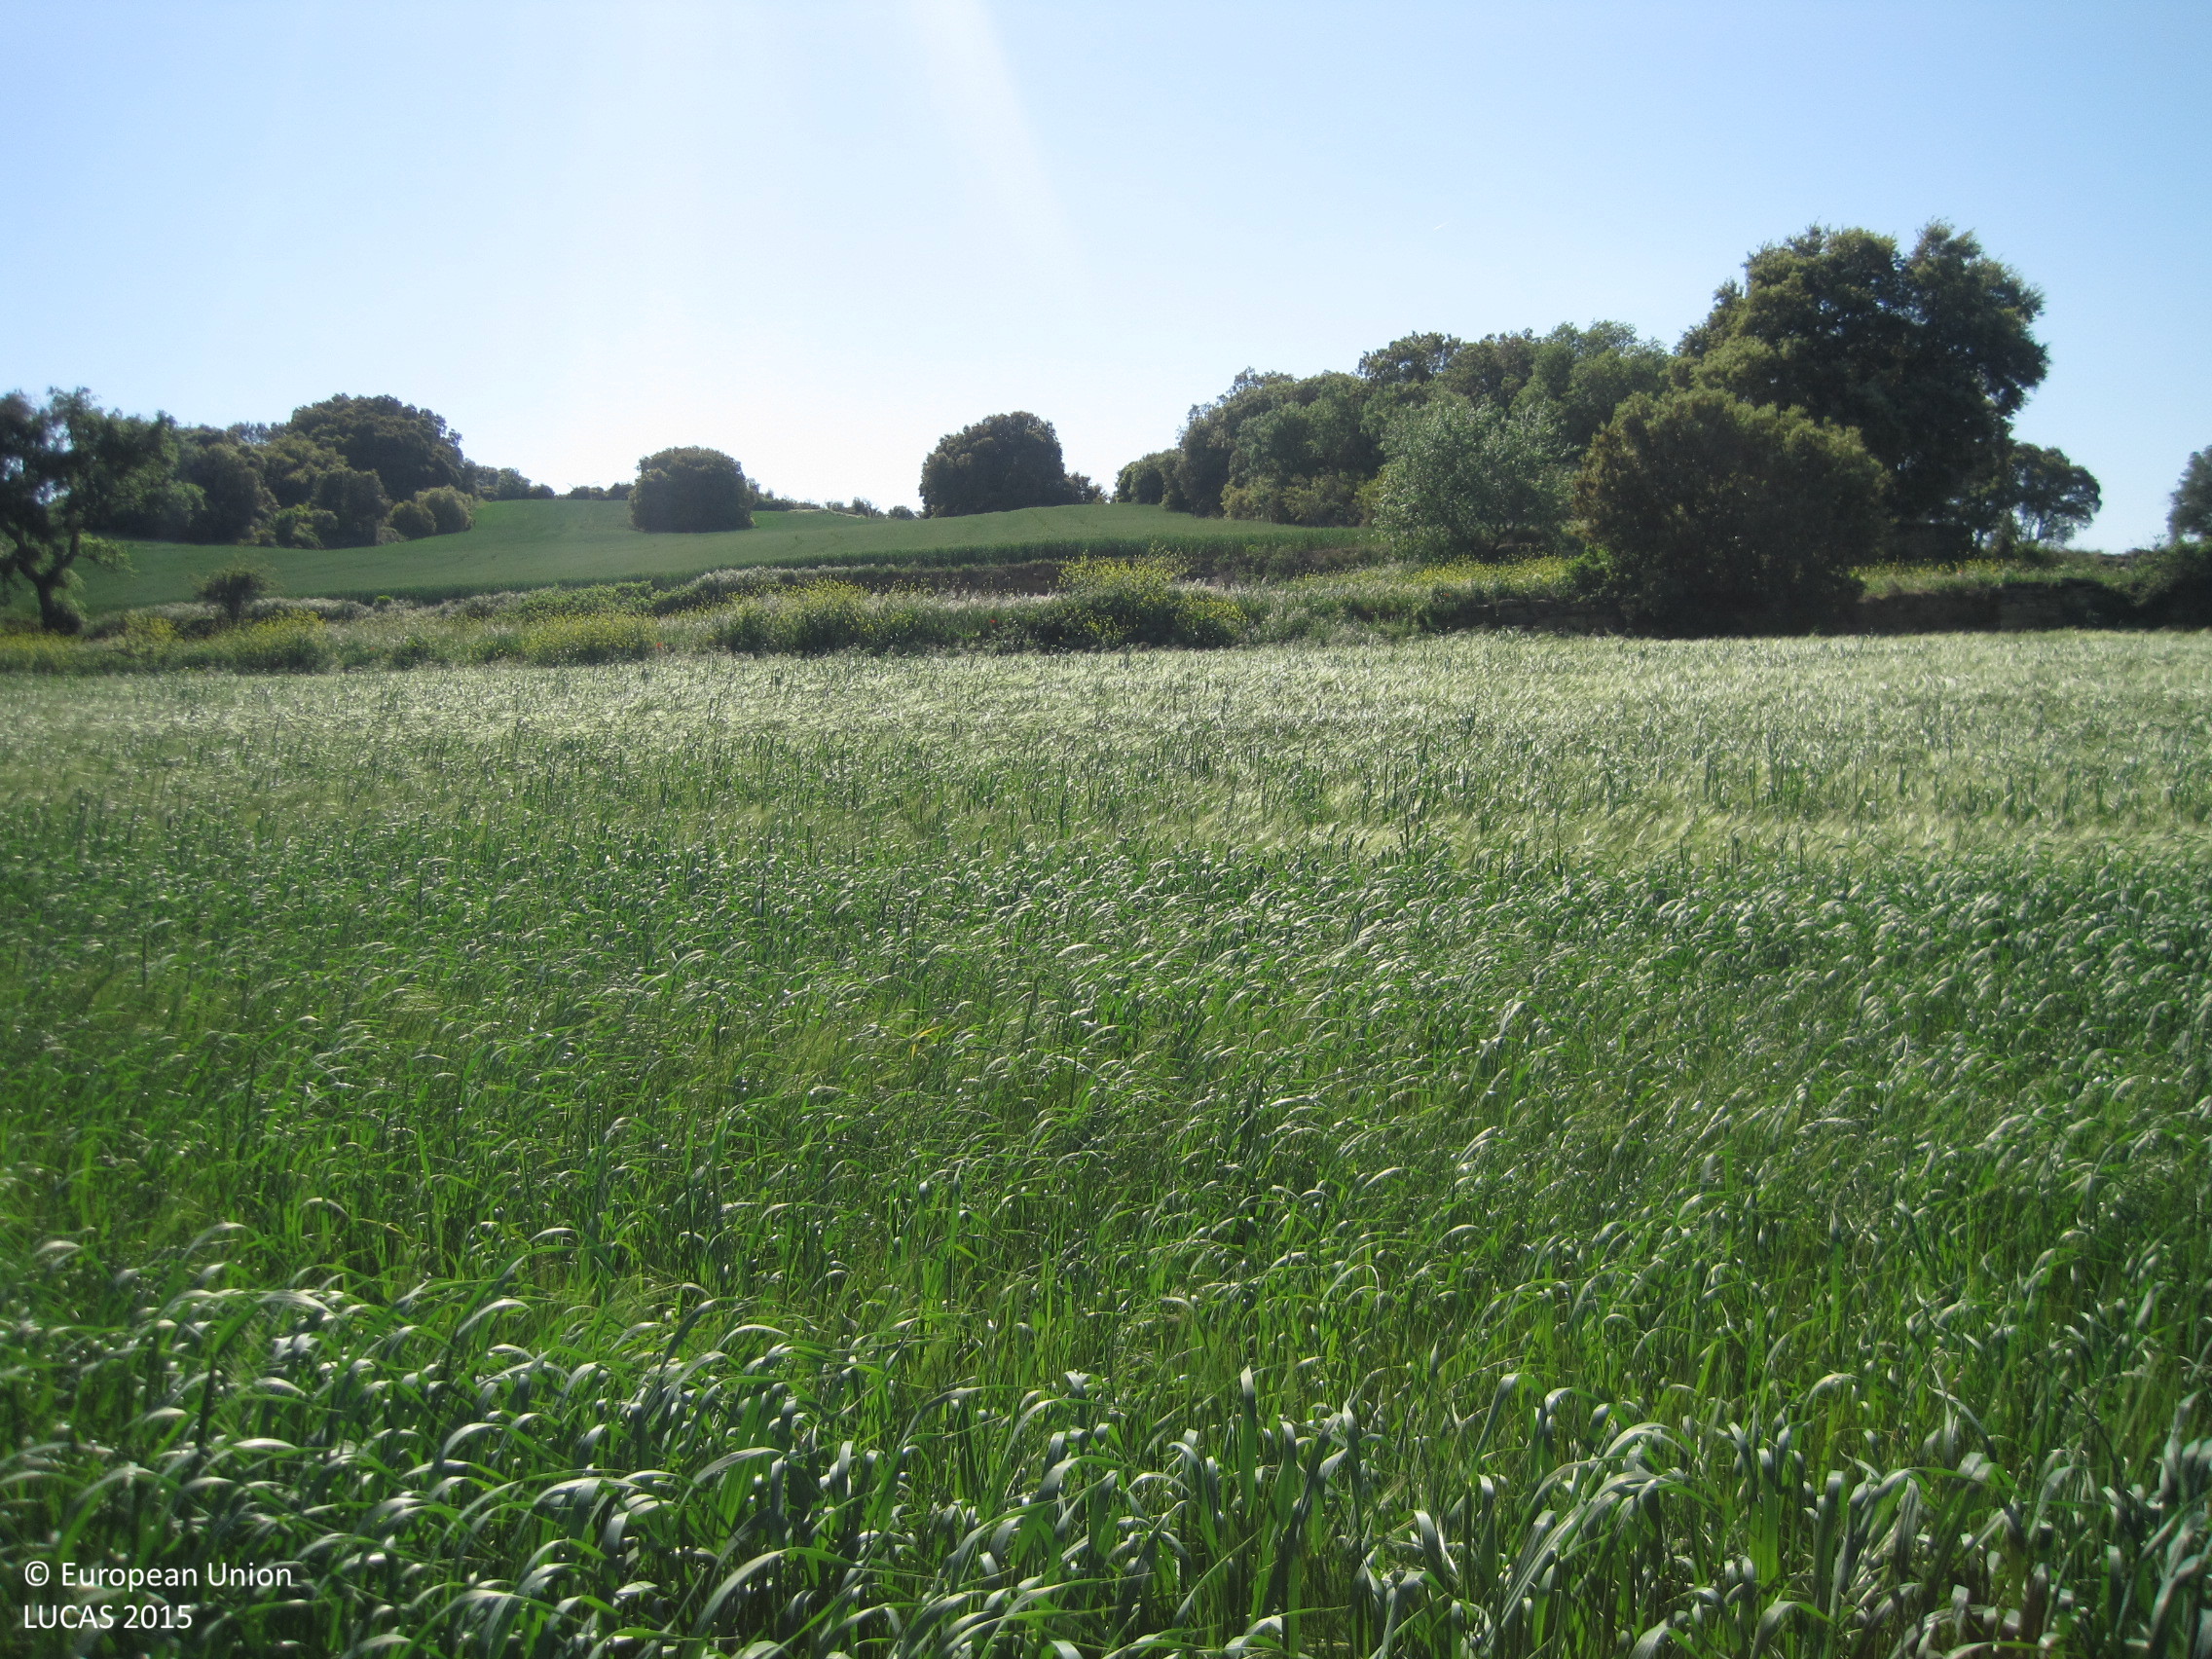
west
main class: Cropland
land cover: Mixed cereals for fodder
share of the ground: > 75 %
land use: Agriculture (excluding fallow land and kitchen gardens)
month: May
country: ES
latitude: 42.5548
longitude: -1.7173
